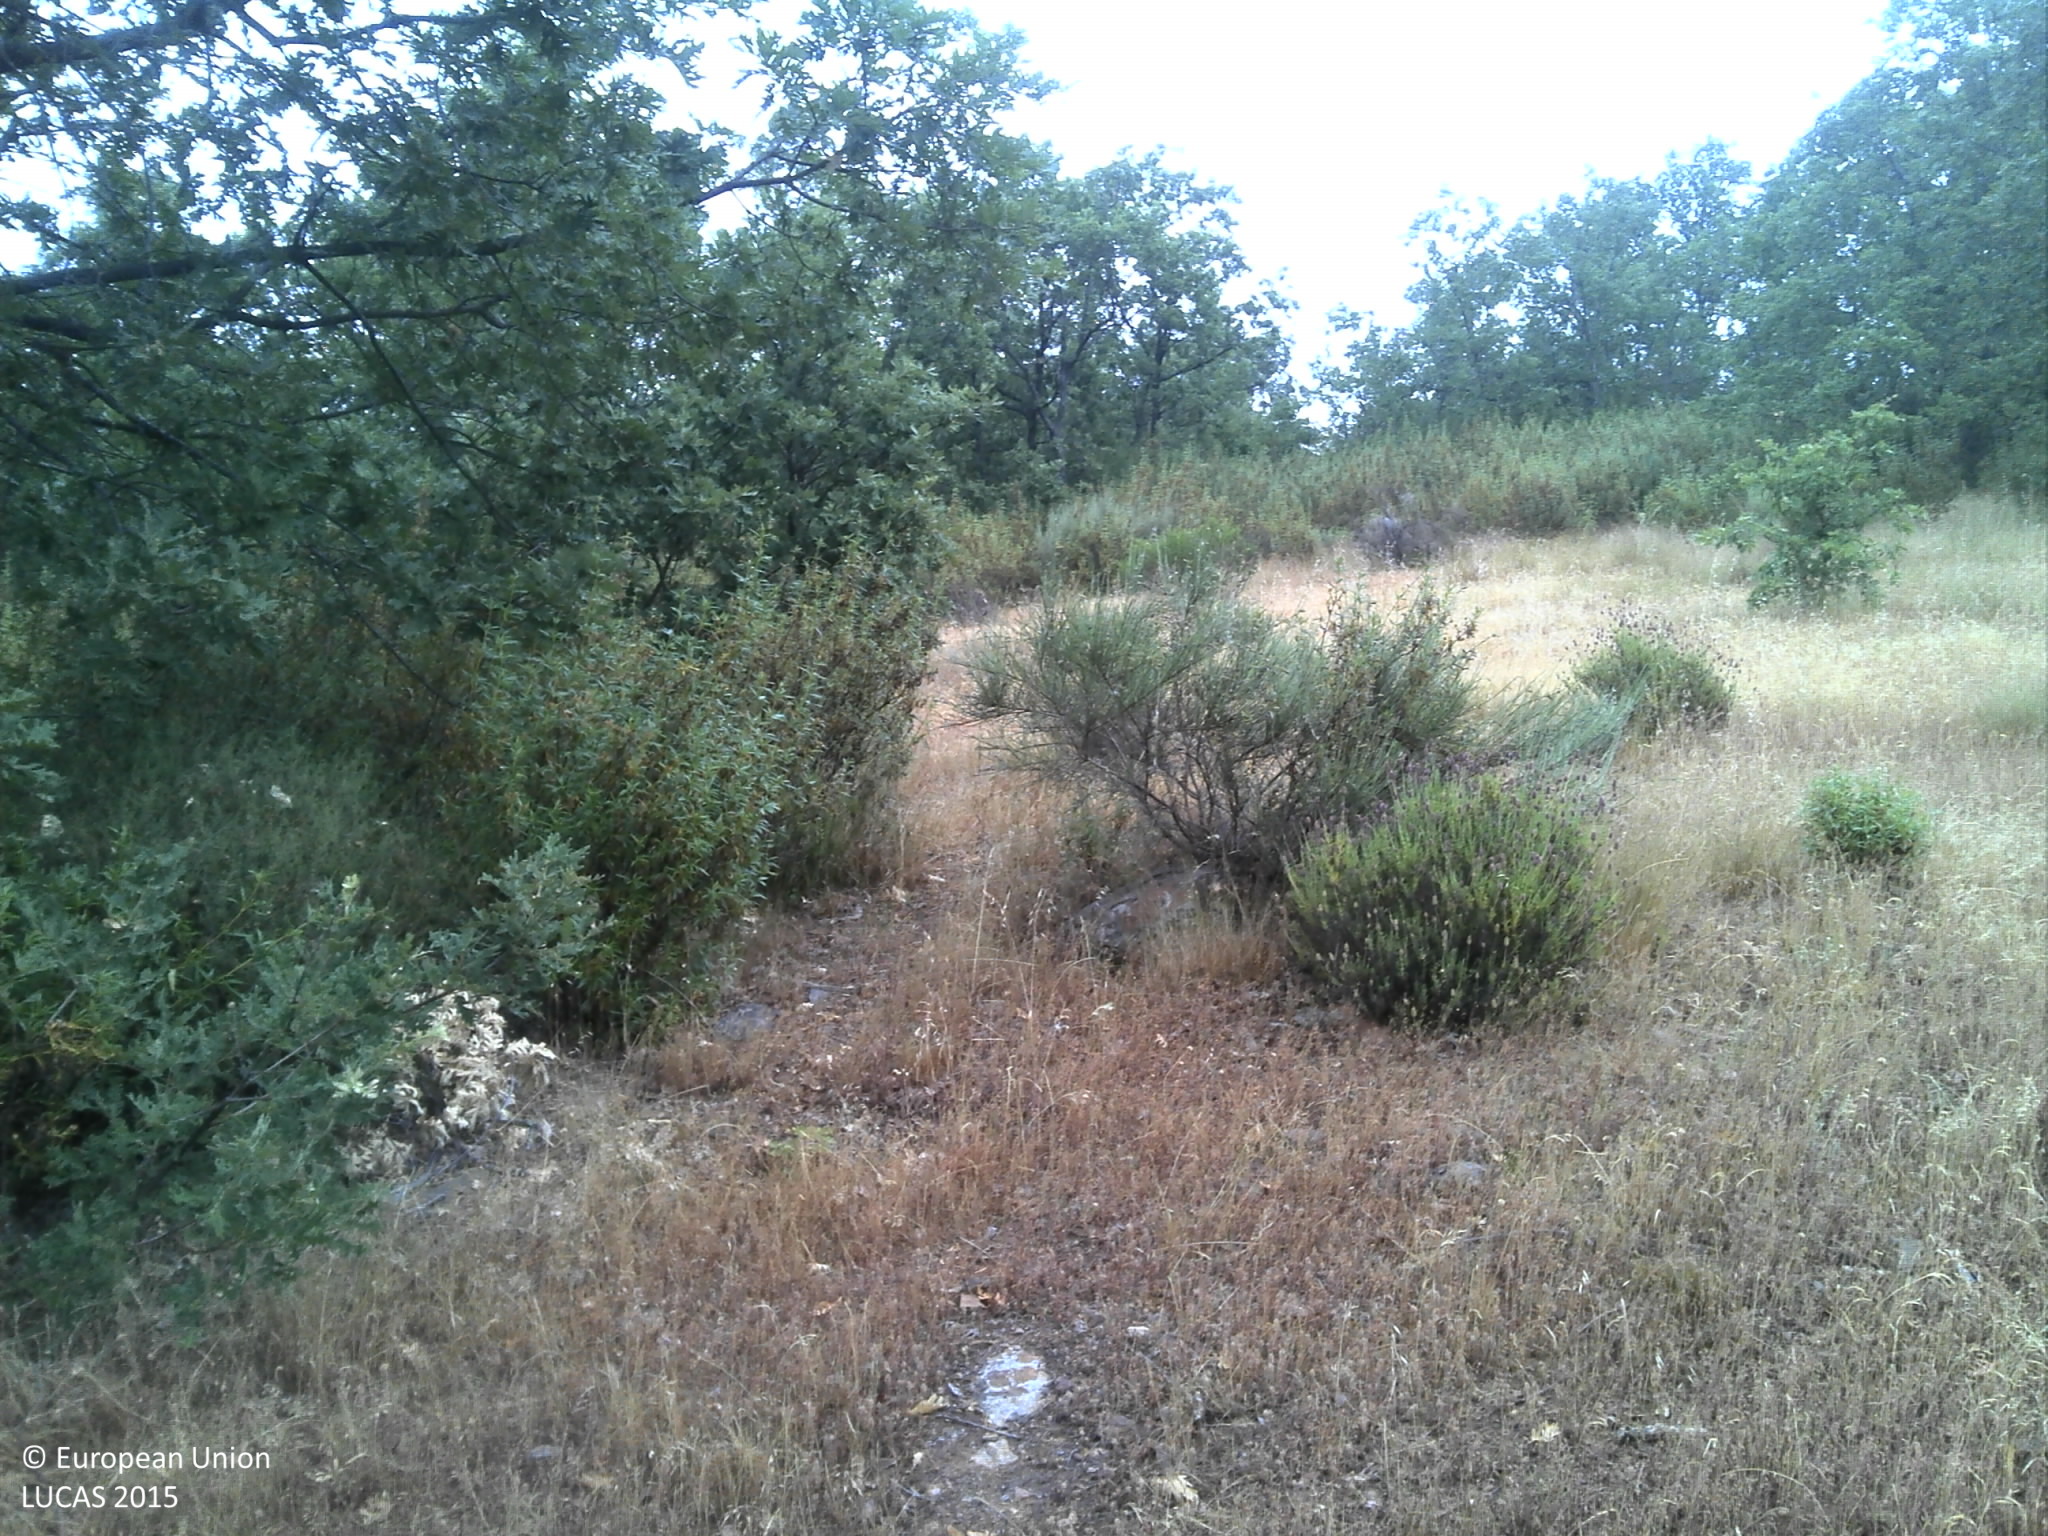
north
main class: Woodland
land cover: Broadleaved woodland
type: acidophilous oak and oak-birch forest
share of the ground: 25 - 50 %
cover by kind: broadleaved forest trees 35 %, herbaceous plants 30 %, unconsolidated bare surface 20 %, shrubs 15 %
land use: Forestry
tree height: > 5 m
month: June
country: PT
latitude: 40.1979
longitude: -7.4795
